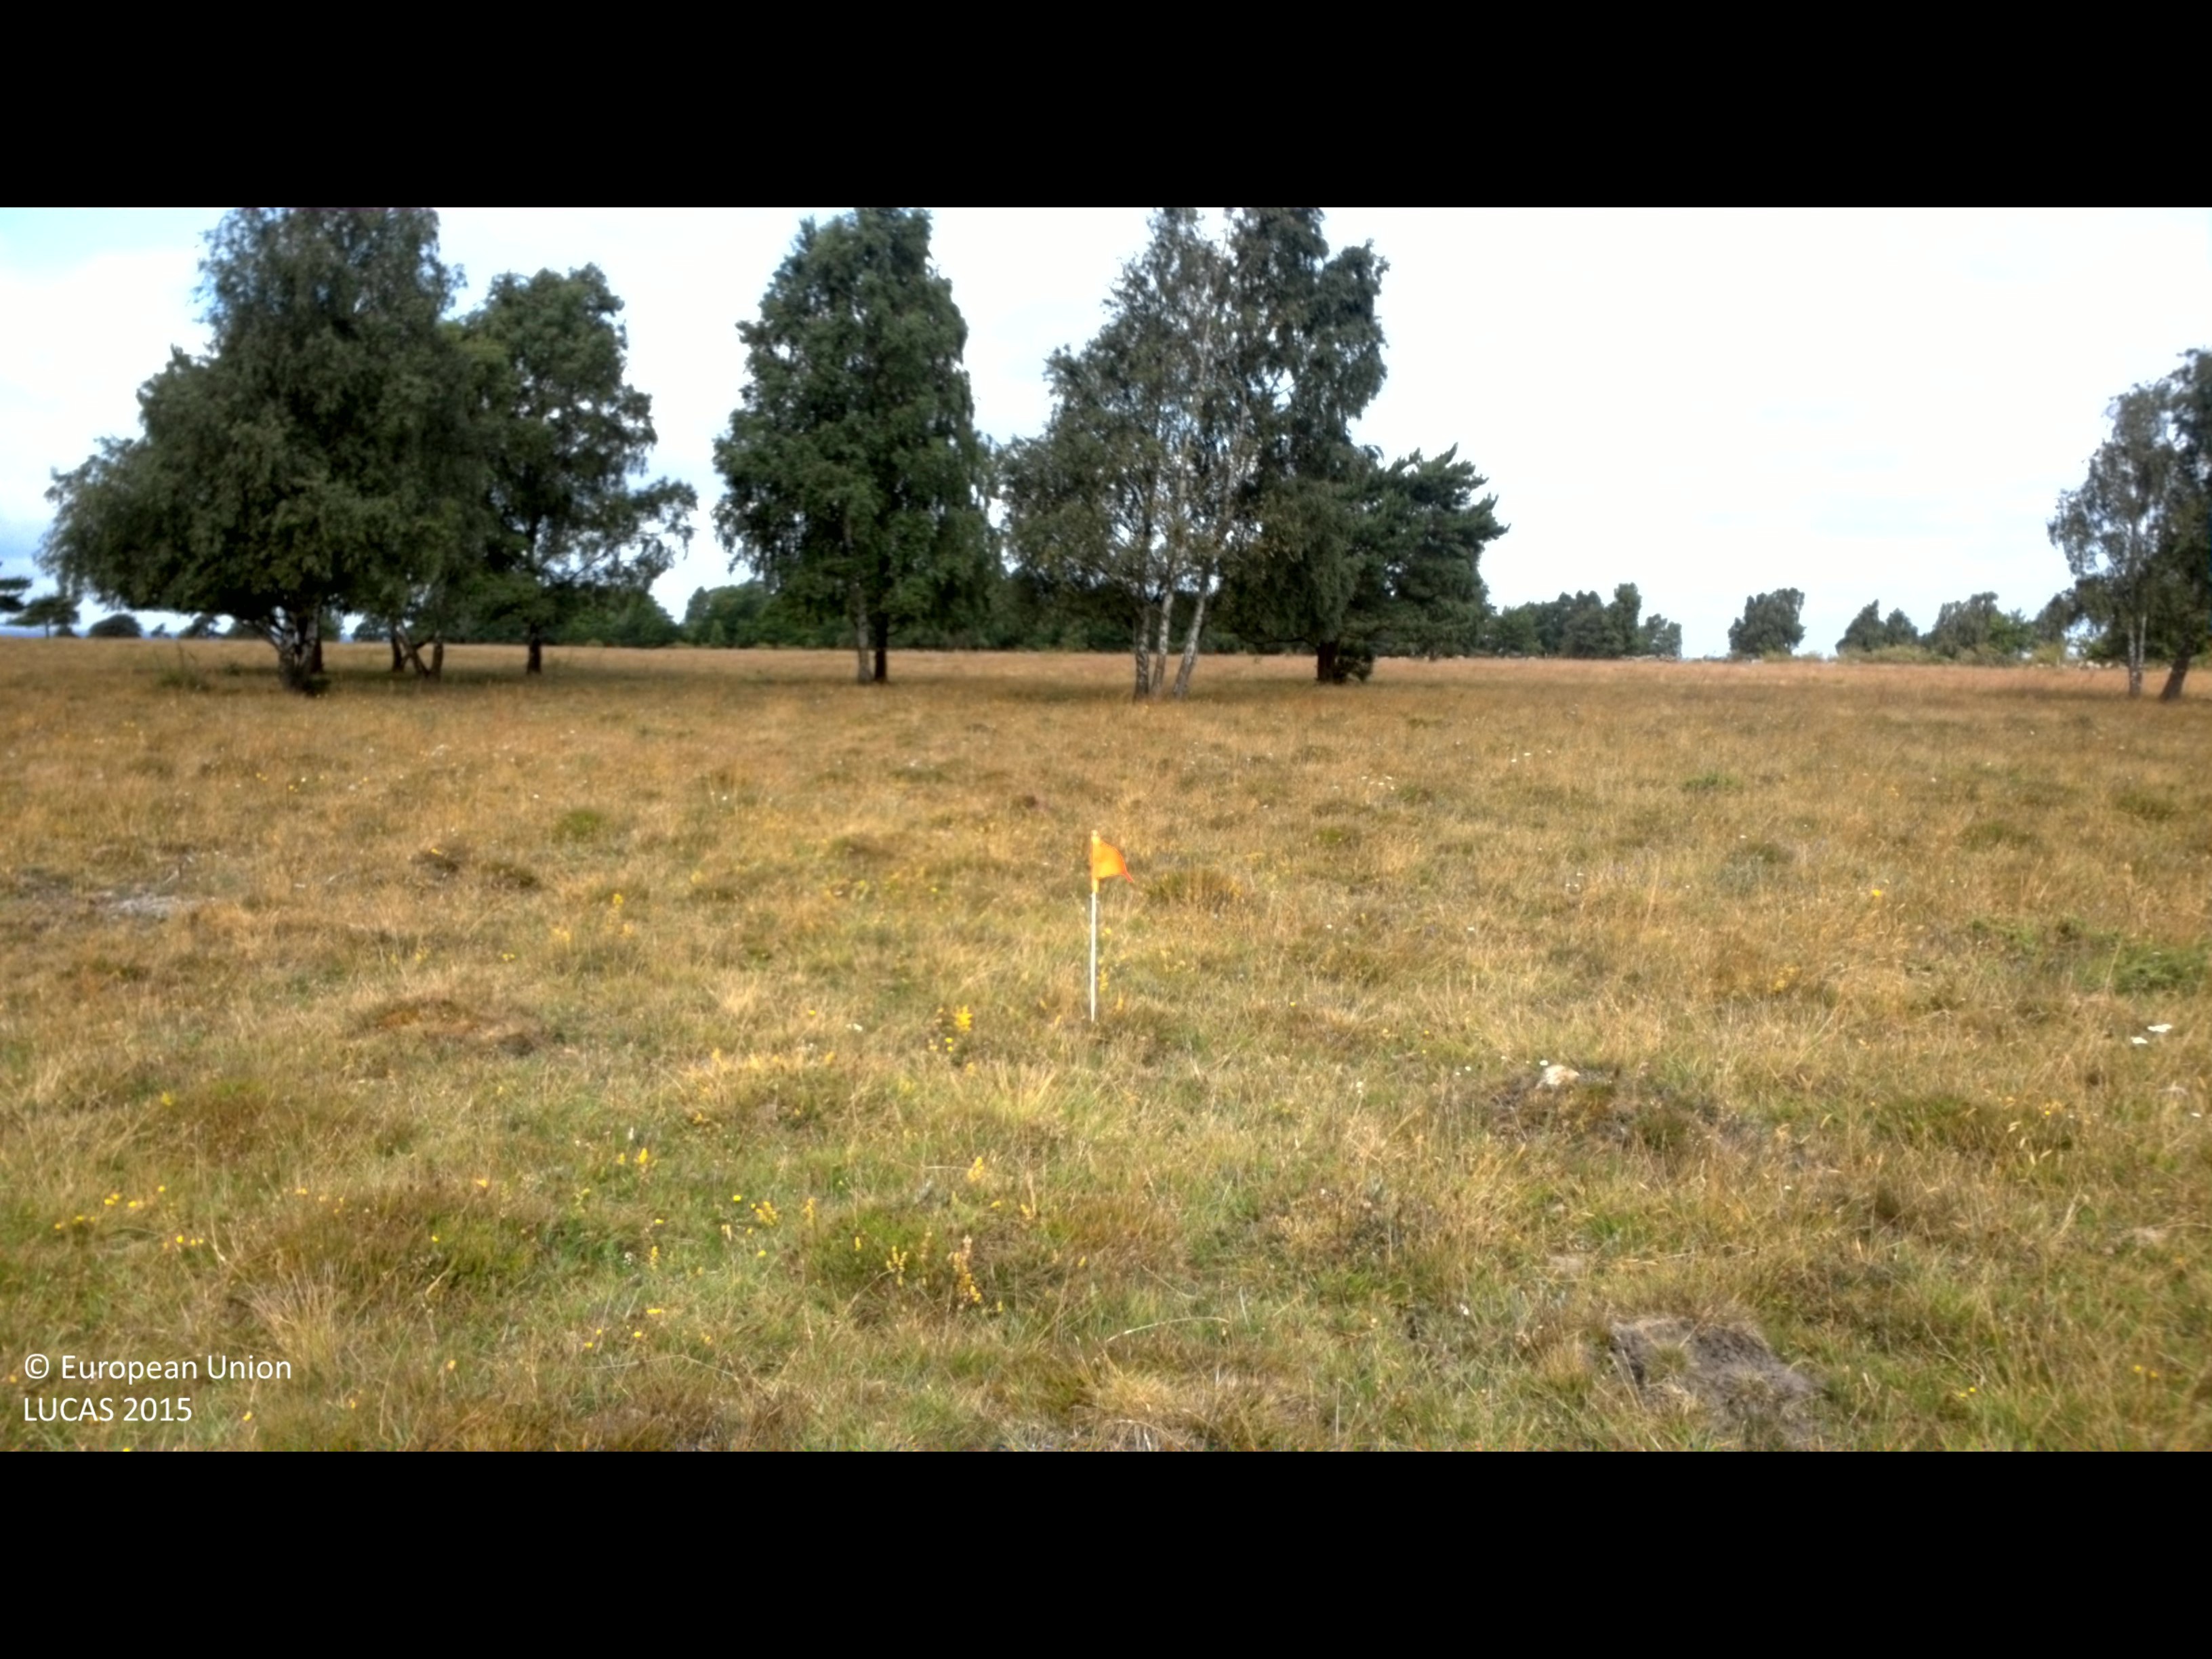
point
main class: Grassland
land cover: Grassland without tree/shrub cover
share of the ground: > 75 %
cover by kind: herbaceous plants 95 %, shrubs 5 %
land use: Agriculture (excluding fallow land and kitchen gardens)
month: July
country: SE
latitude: 56.4800
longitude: 16.3825
